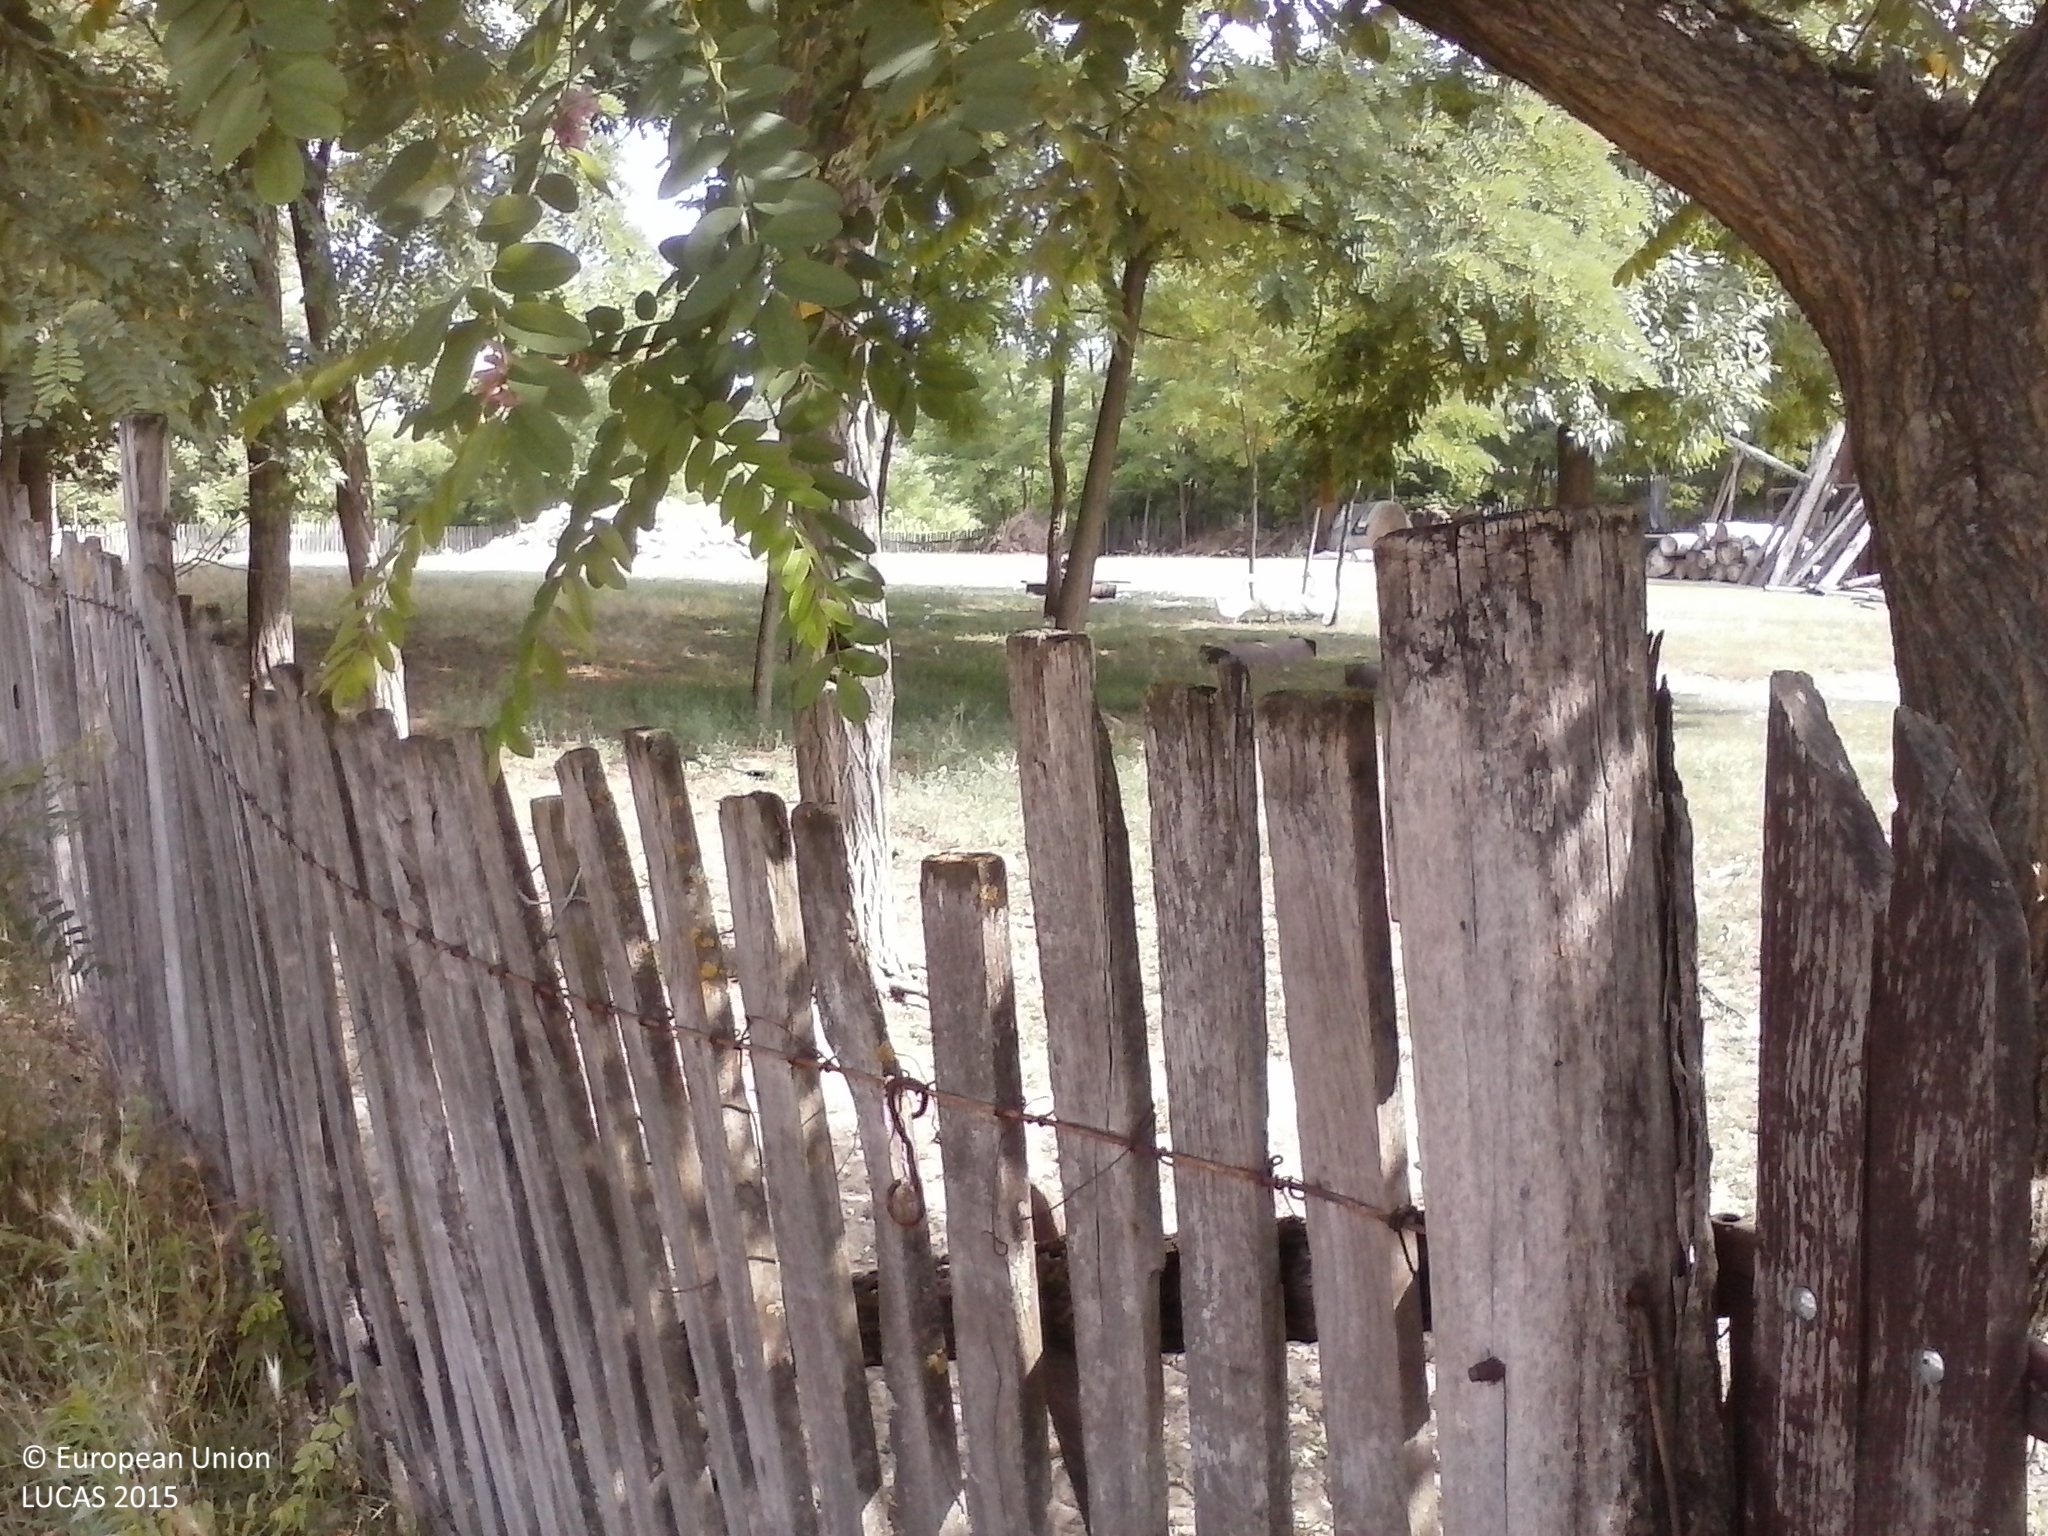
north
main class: Artificial land
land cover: Non built-up area features
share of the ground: > 75 %
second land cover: Spontaneously vegetated surfaces
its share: > 75 %
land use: Residential
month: June
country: HU
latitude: 46.2401
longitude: 19.6532
